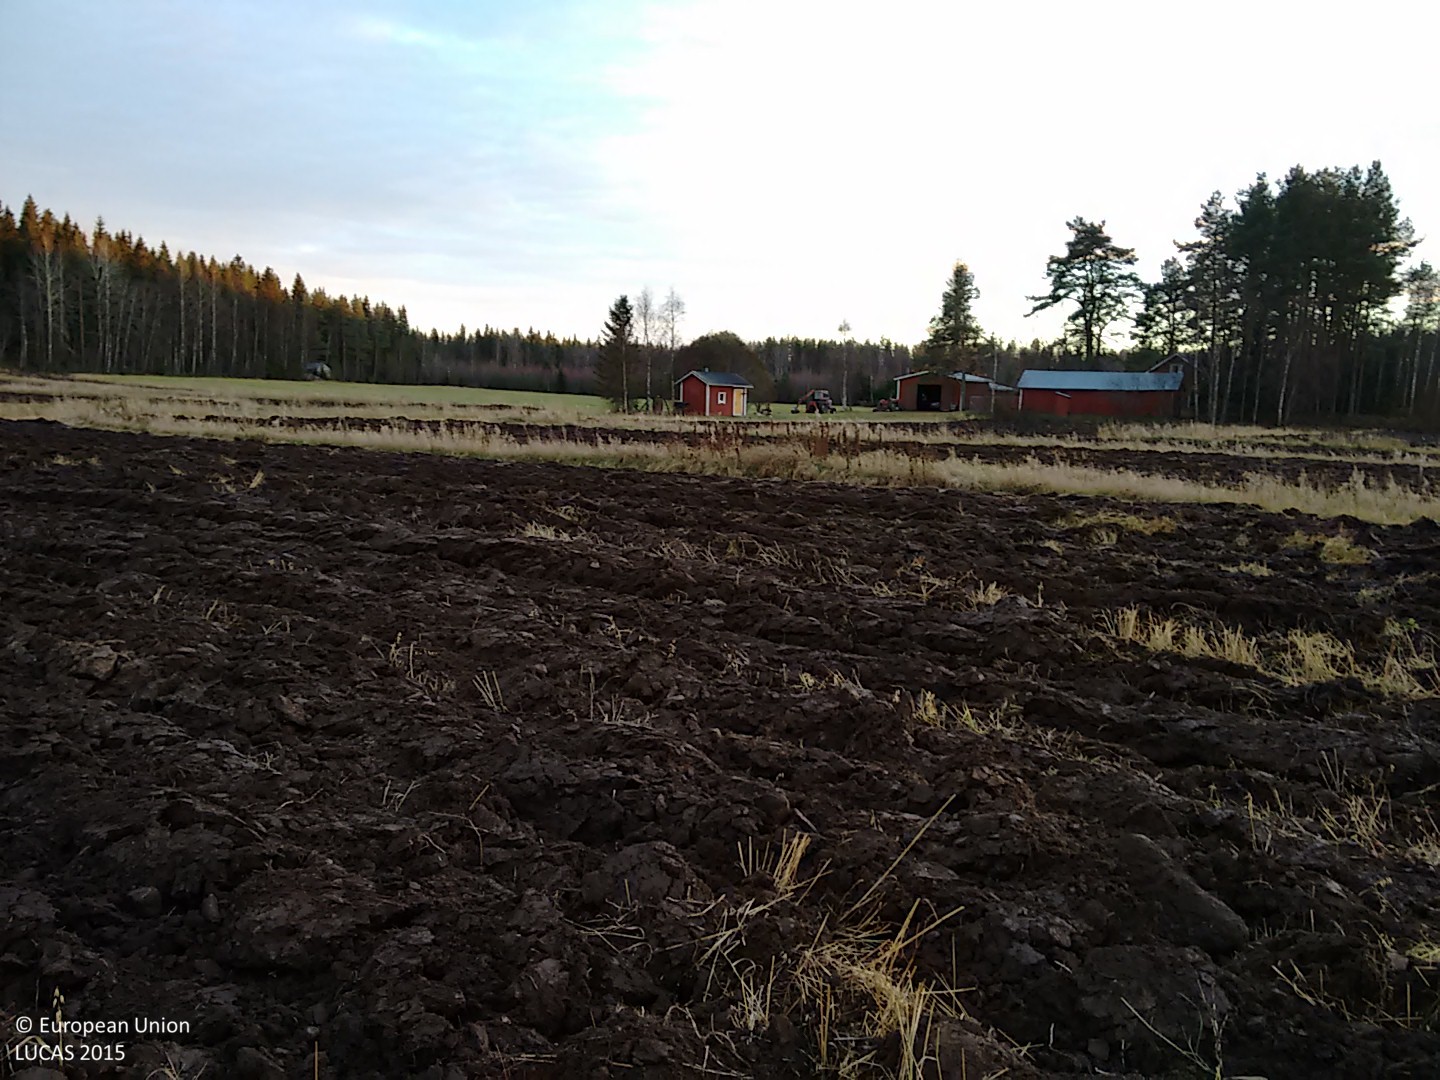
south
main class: Cropland
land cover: Oats
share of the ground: < 10 %
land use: Agriculture (excluding fallow land and kitchen gardens)
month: October
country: FI
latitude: 64.6350
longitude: 24.6530
